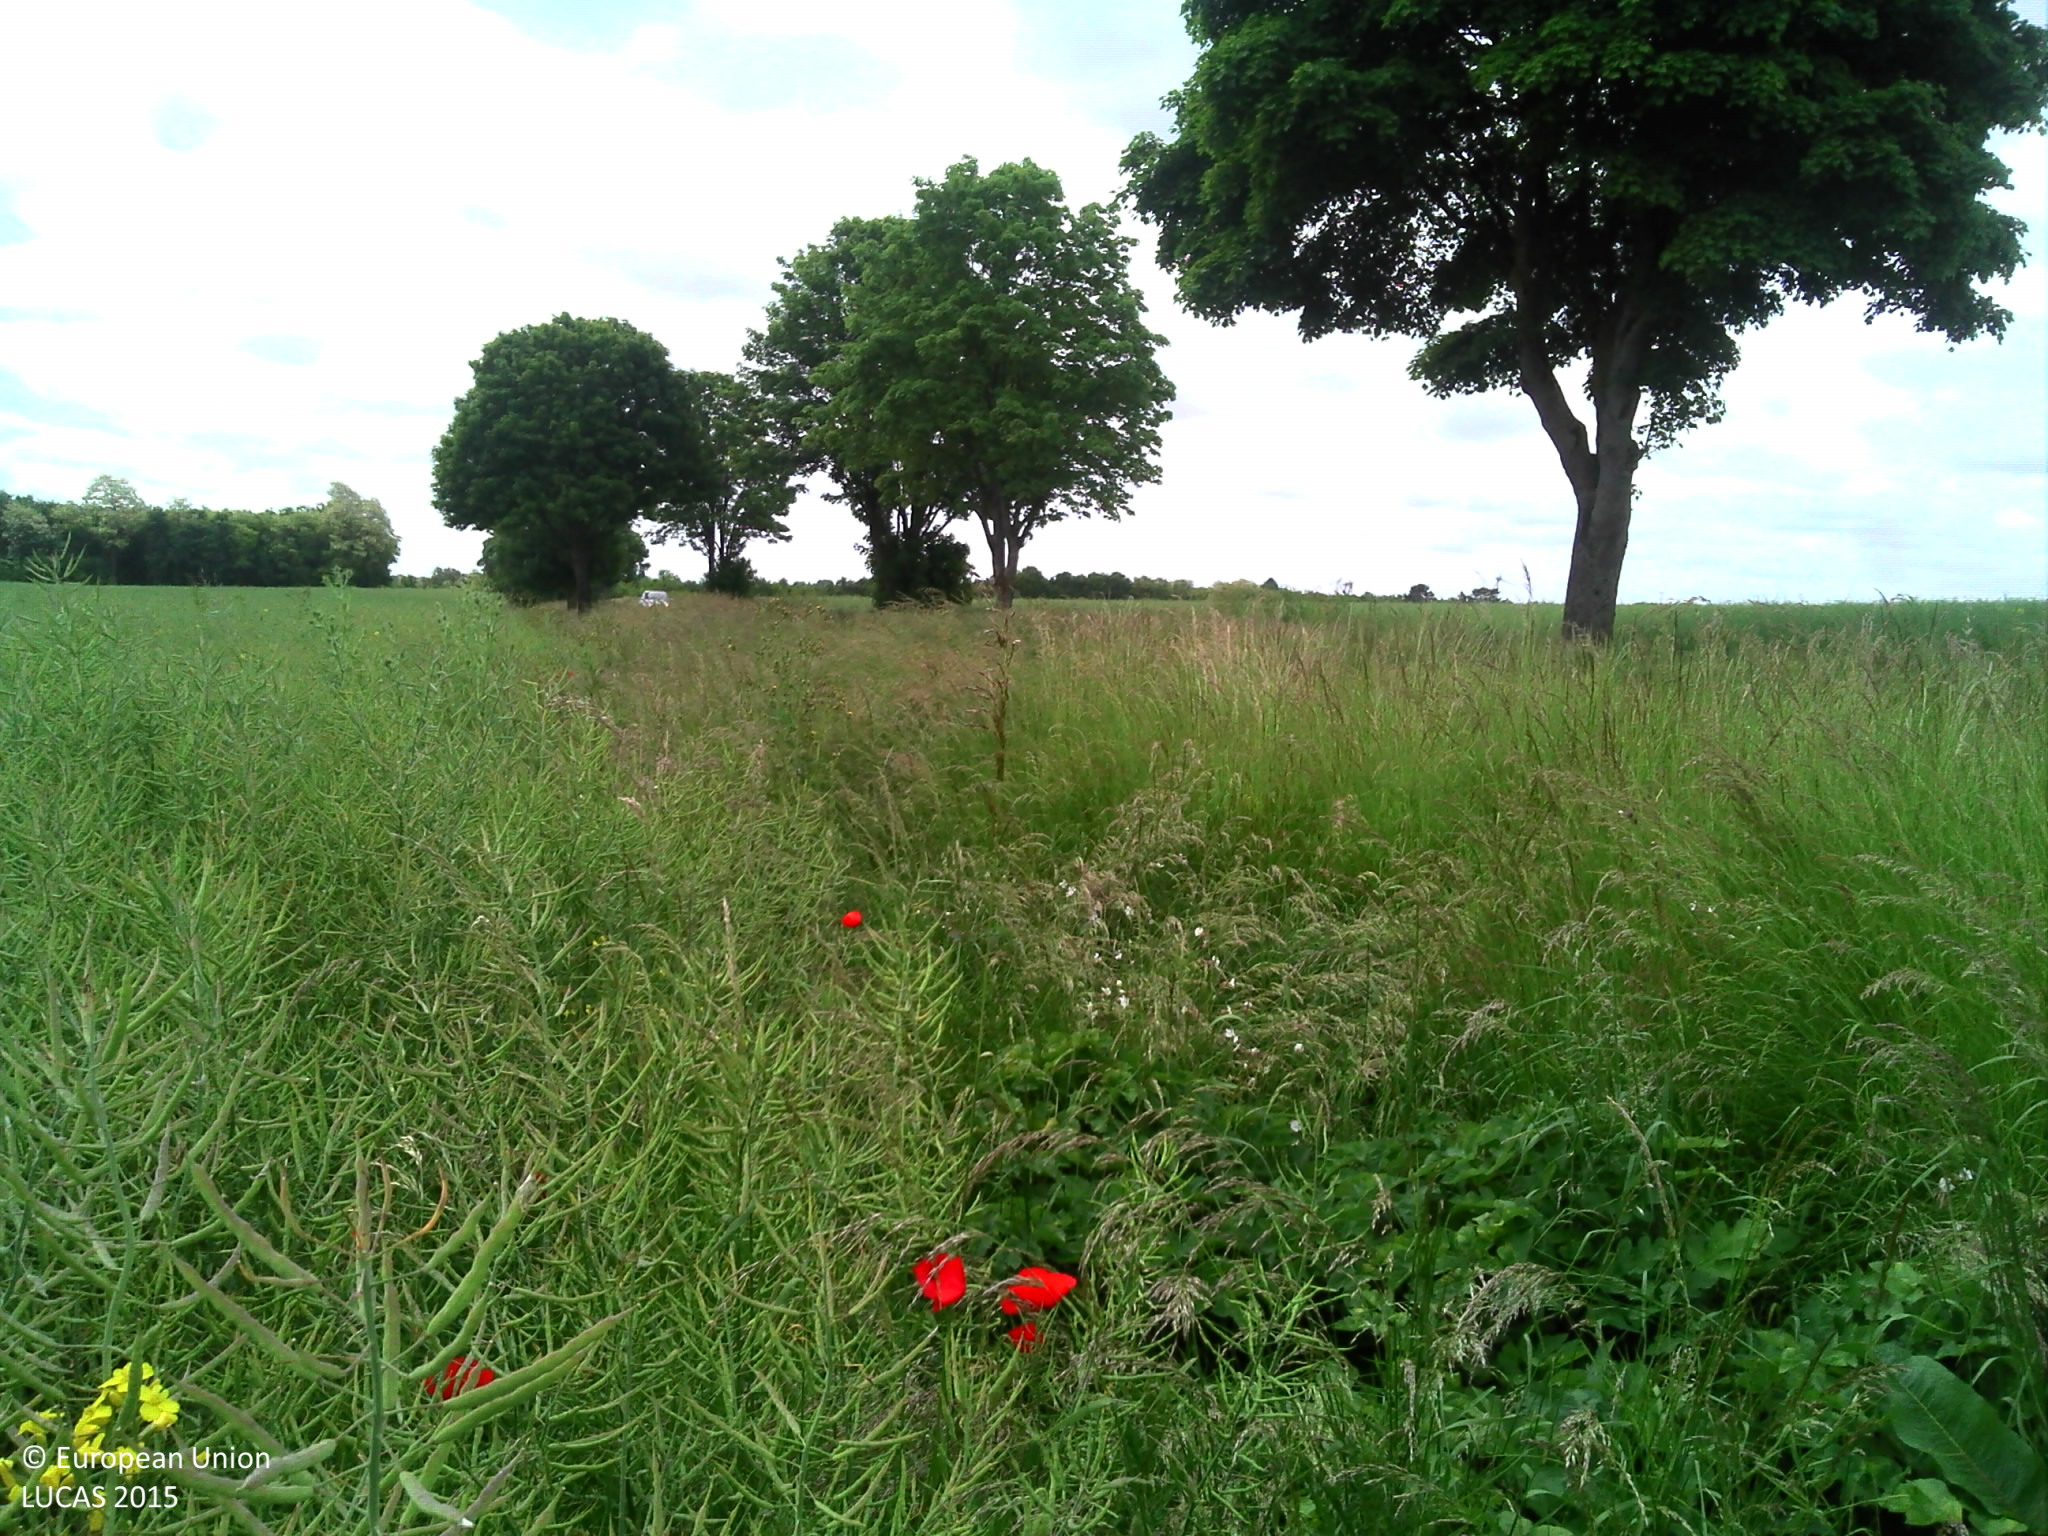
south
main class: Cropland
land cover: Rape and turnip rape
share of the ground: > 75 %
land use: Agriculture (excluding fallow land and kitchen gardens)
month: June
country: FR
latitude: 48.3652
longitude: 1.9824
